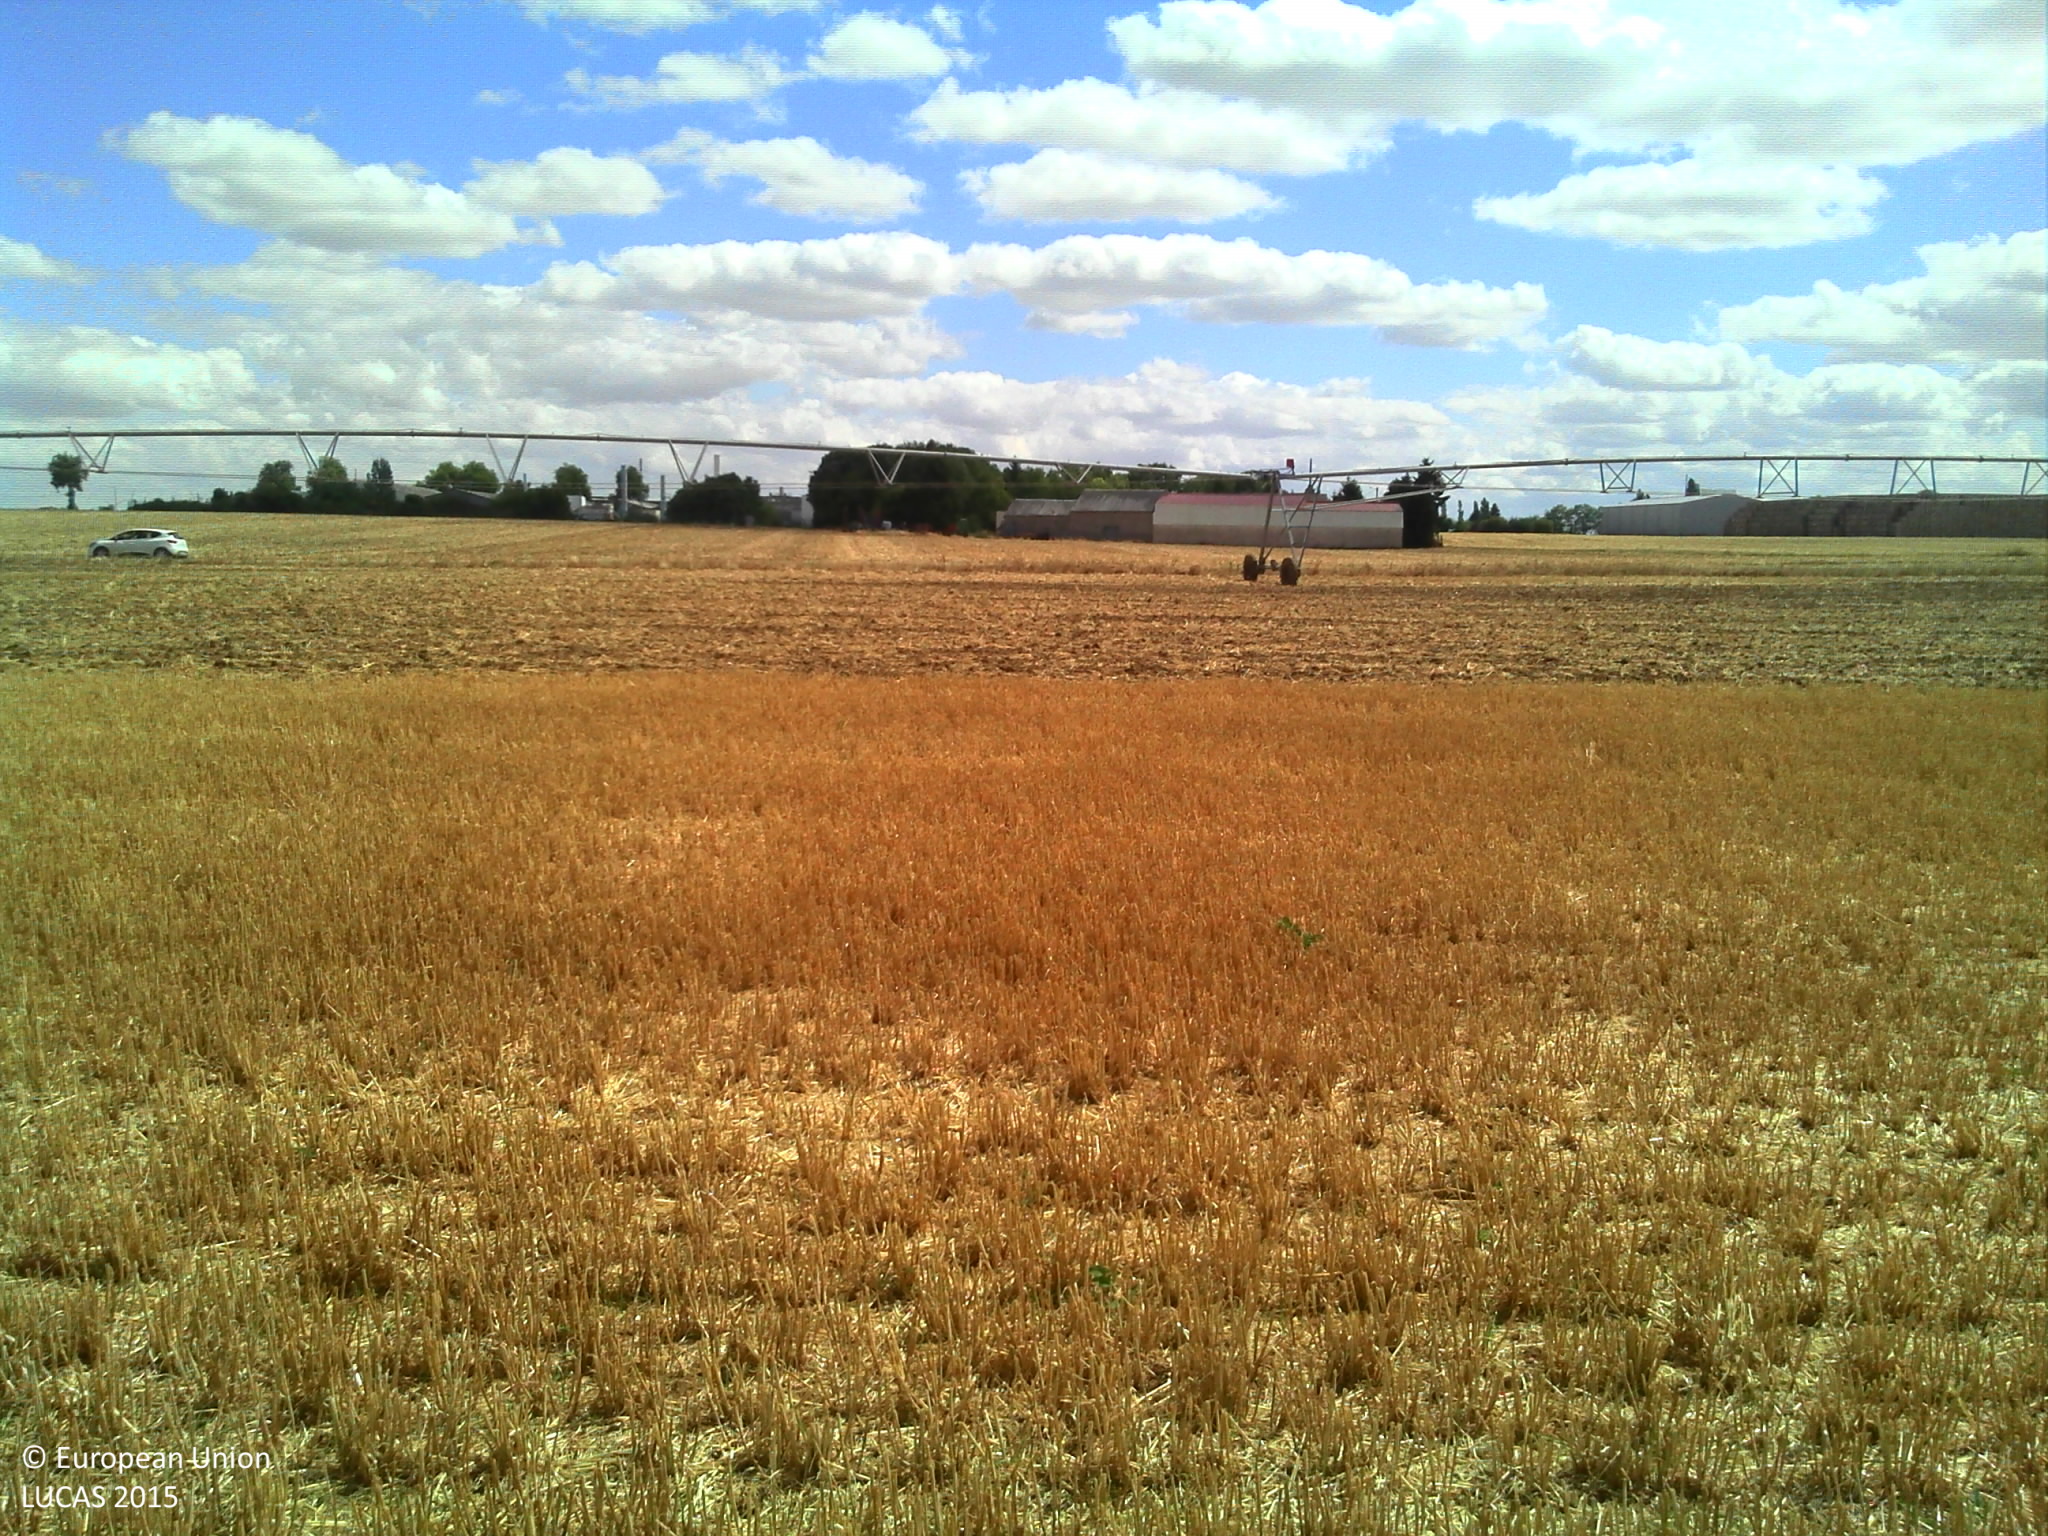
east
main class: Cropland
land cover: Common wheat
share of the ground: > 75 %
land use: Agriculture (excluding fallow land and kitchen gardens)
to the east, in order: Common wheat; Tracks; Triticale
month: August
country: FR
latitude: 48.2043
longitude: 2.0080
